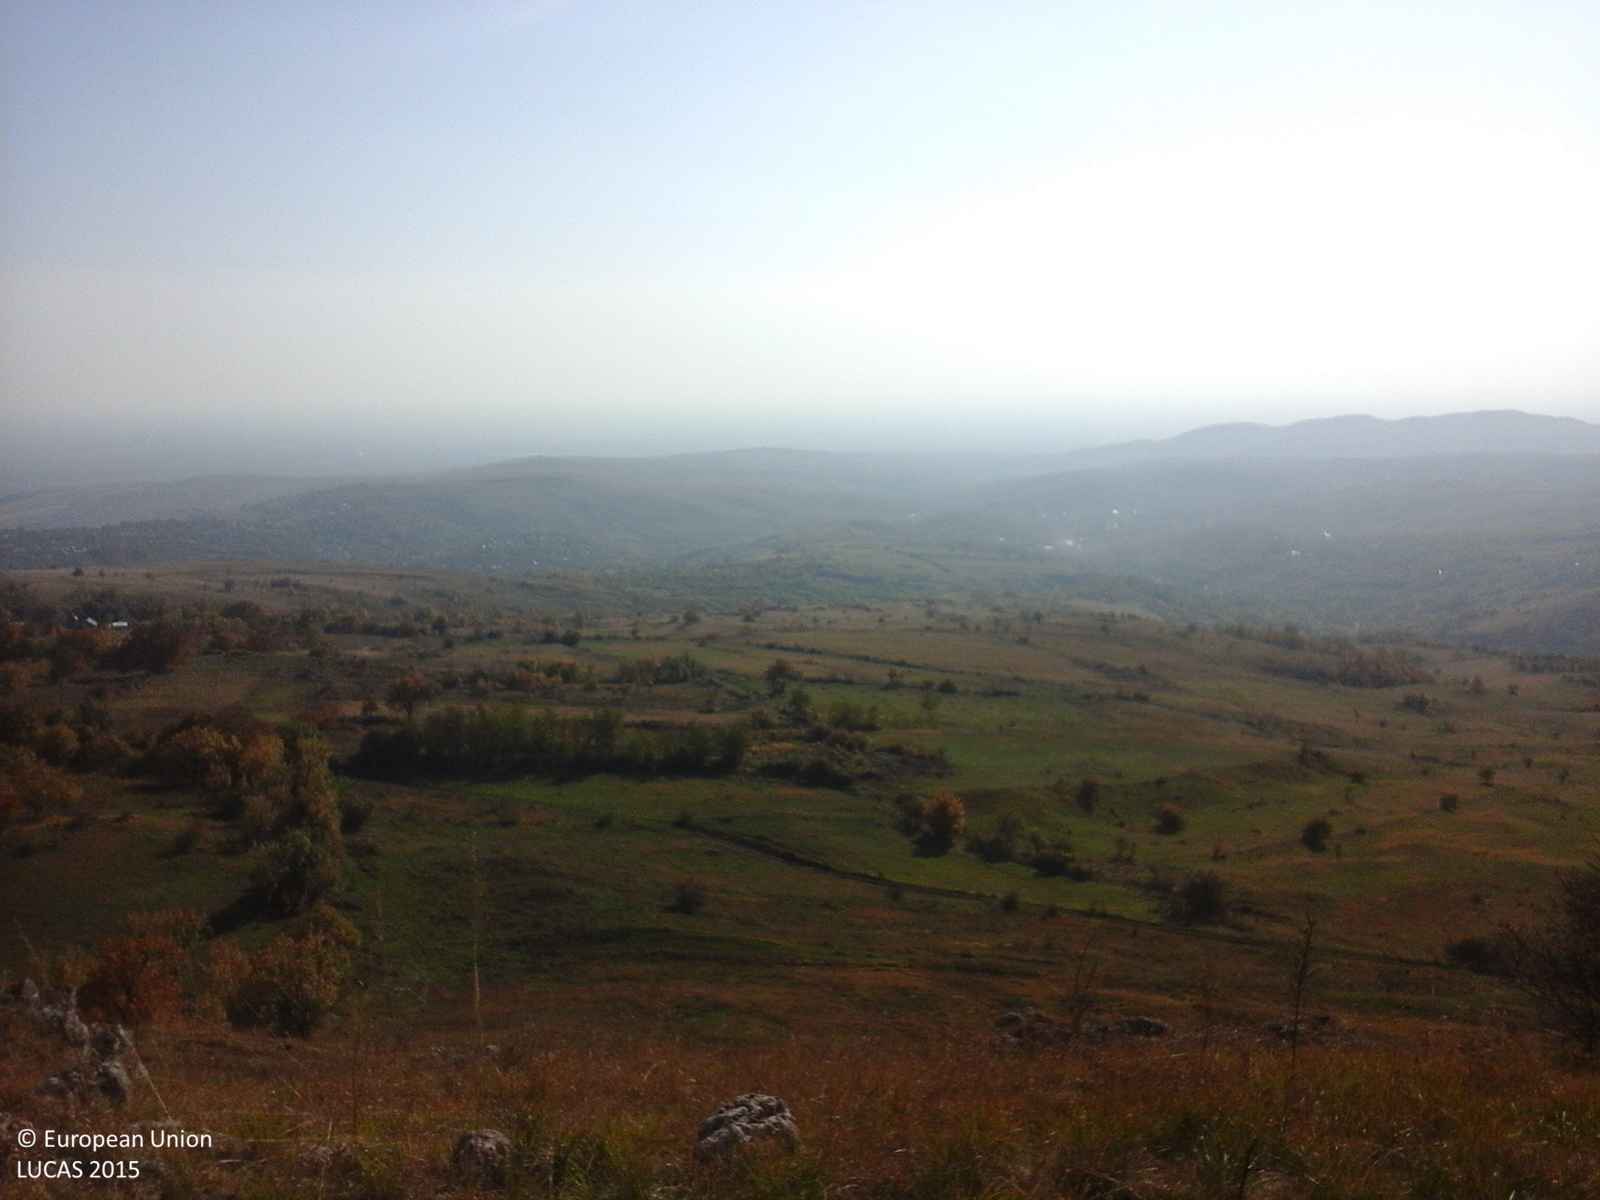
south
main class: Grassland
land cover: Grassland without tree/shrub cover
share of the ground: > 75 %
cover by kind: herbaceous plants 100 %
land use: Agriculture (excluding fallow land and kitchen gardens)
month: October
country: RO
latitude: 45.1165
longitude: 26.4813
